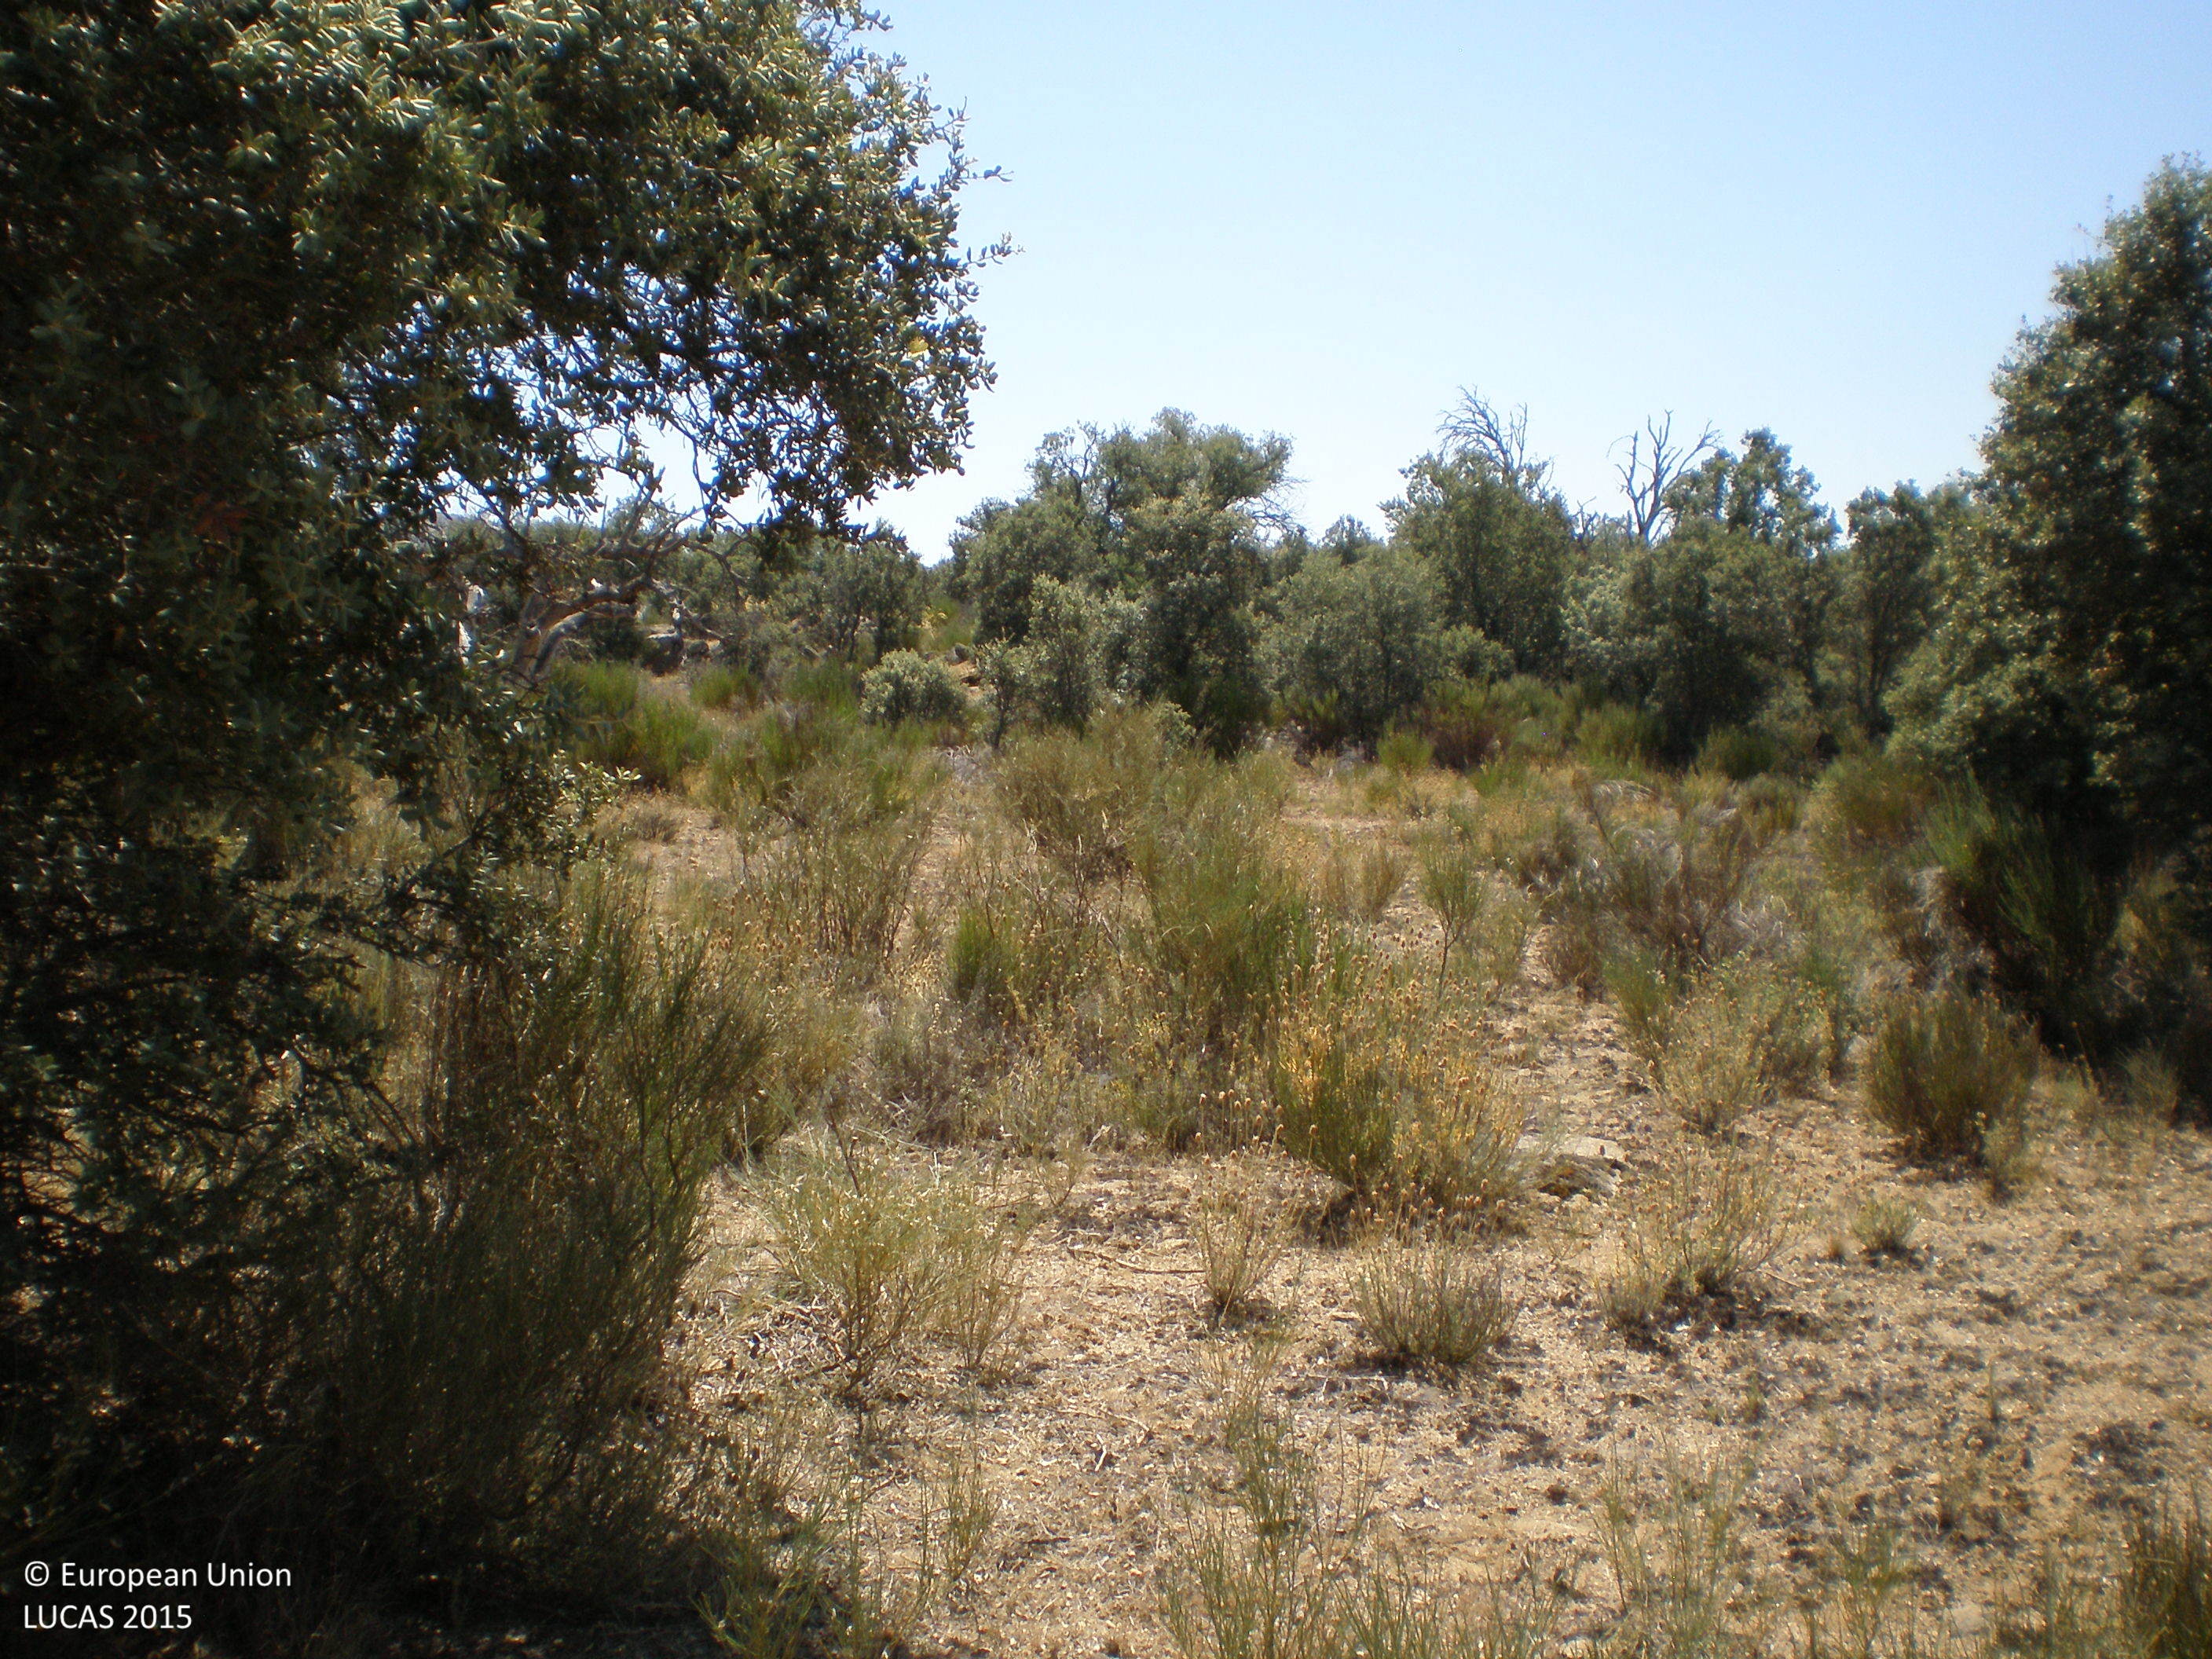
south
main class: Woodland
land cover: Broadleaved woodland
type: broadleaved evergreen forest
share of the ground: 25 - 50 %
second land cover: Grassland without tree/shrub cover
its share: 50 - 75 %
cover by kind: herbaceous plants 70 %, broadleaved forest trees 30 %
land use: Forestry
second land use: Agriculture (excluding fallow land and kitchen gardens)
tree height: > 5 m
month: July
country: ES
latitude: 40.4211
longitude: -5.5179
